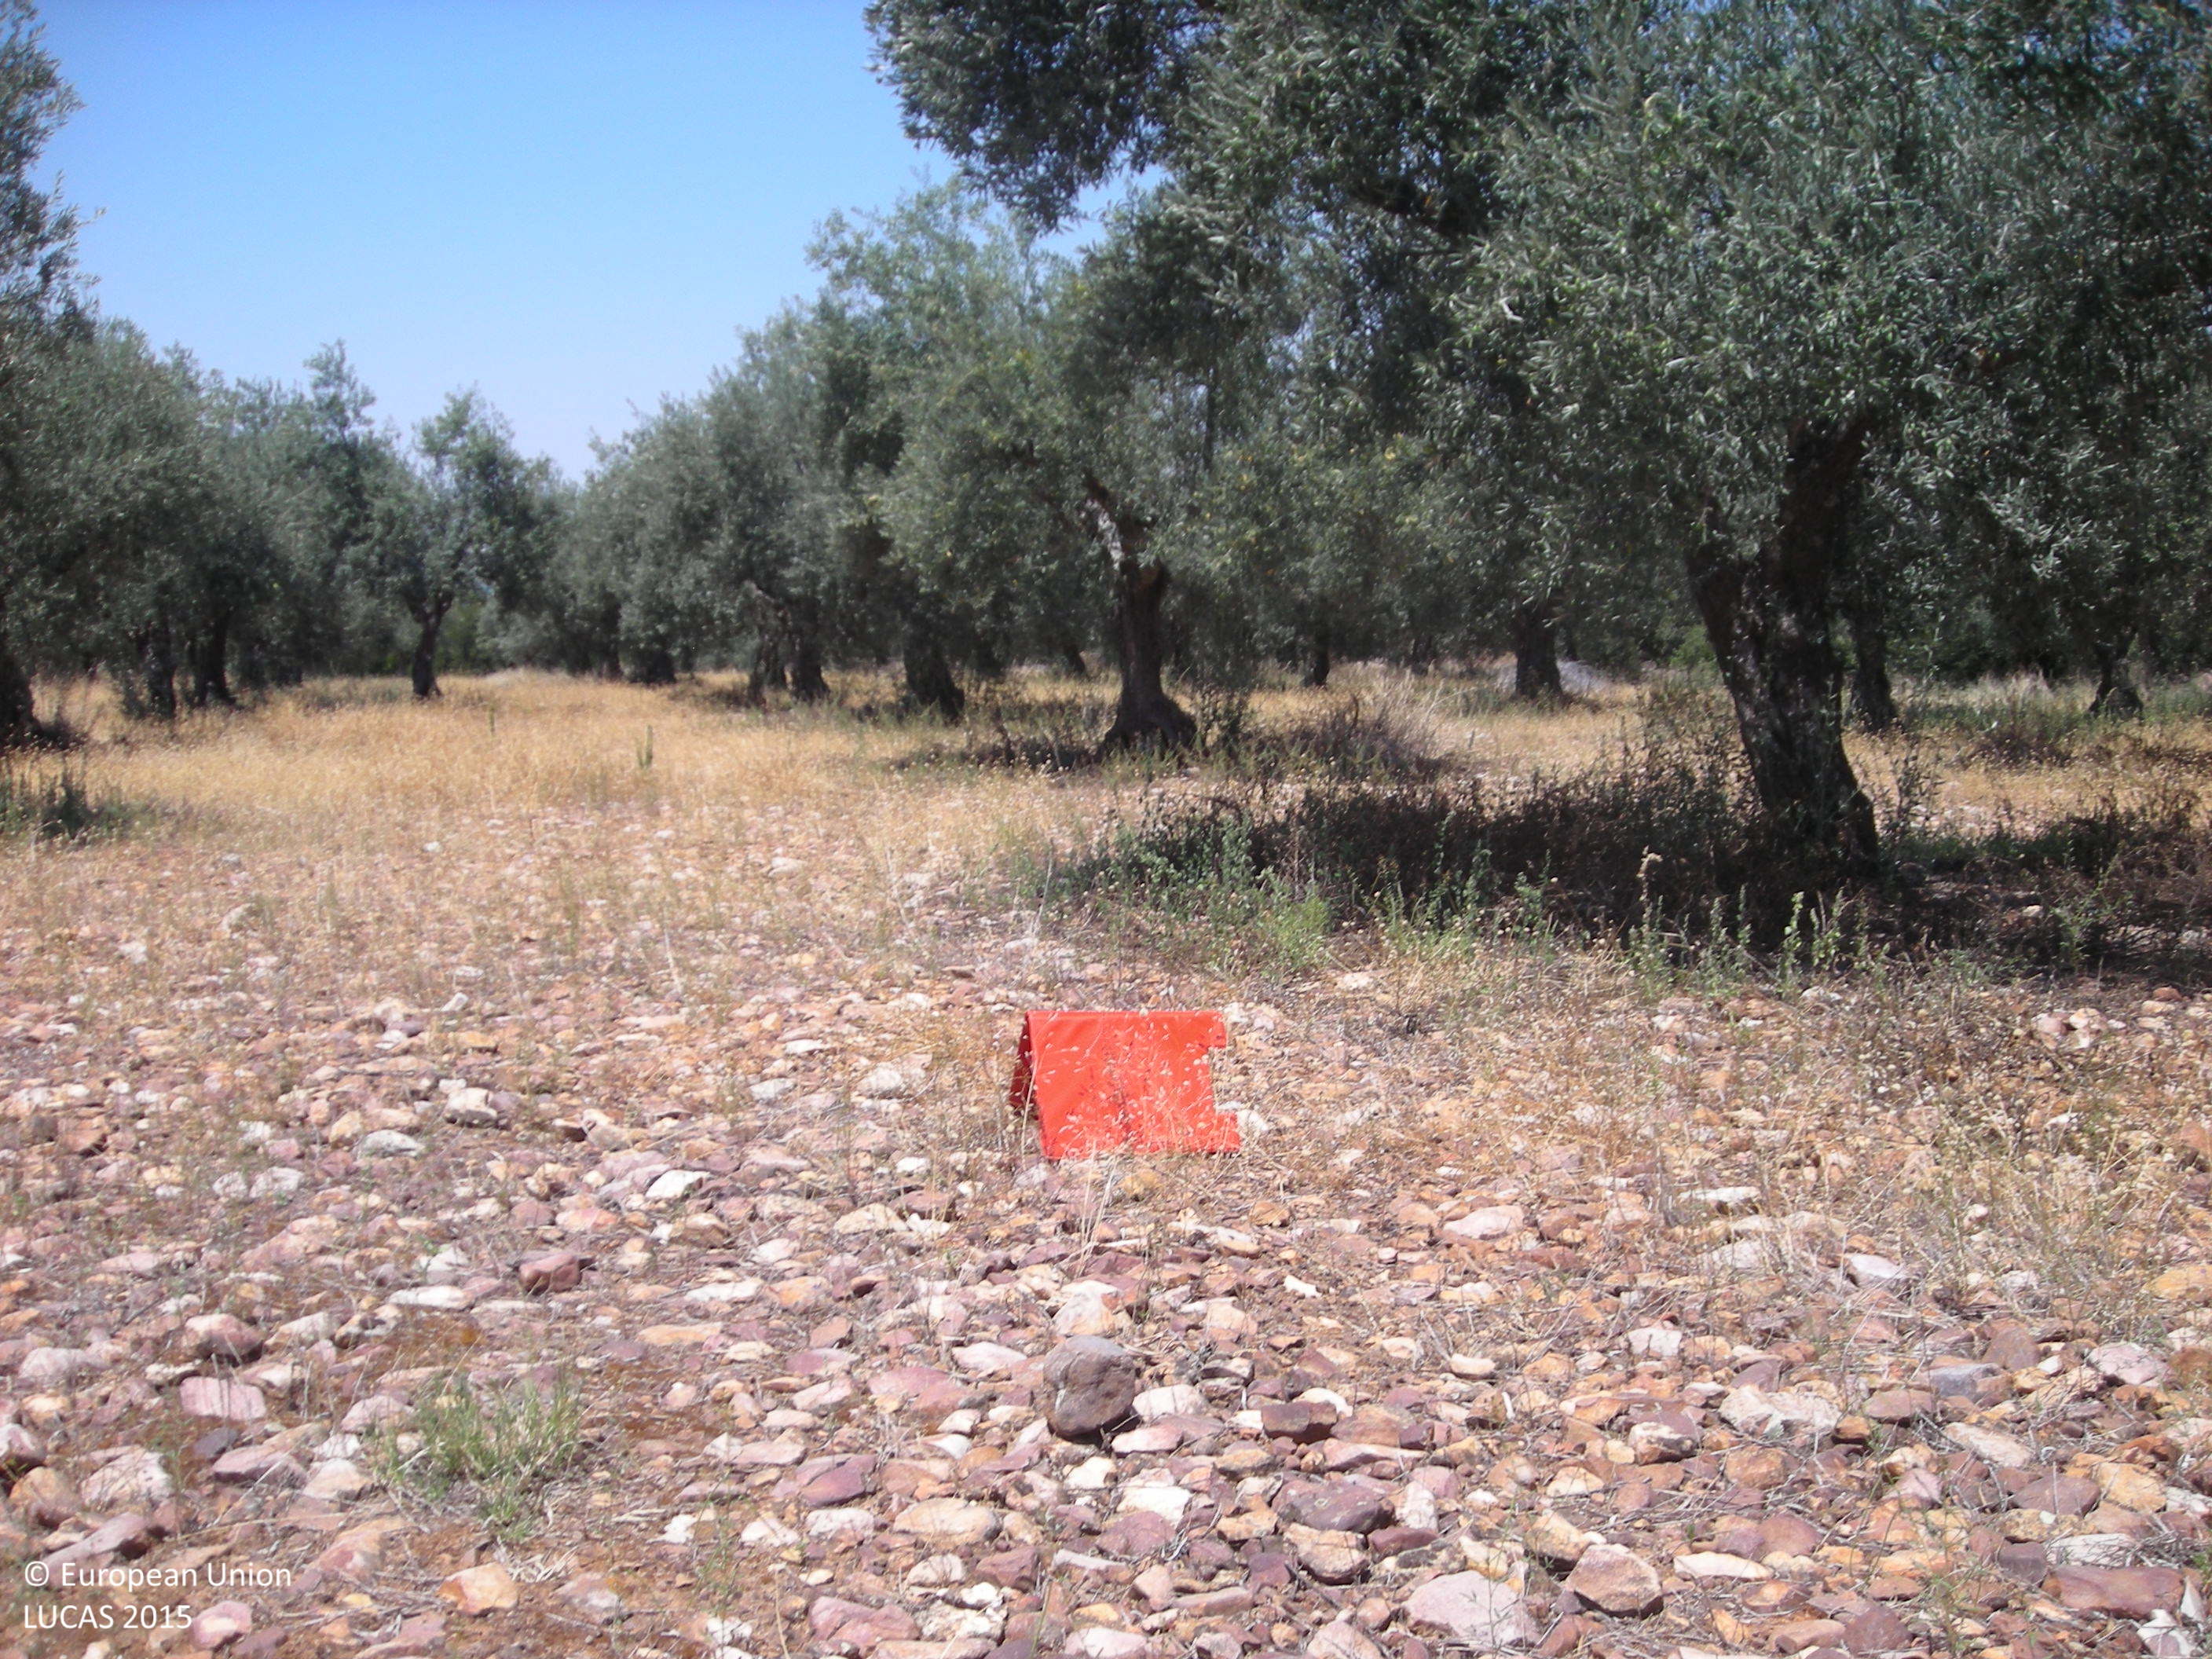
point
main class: Cropland
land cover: Olive groves
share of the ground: 50 - 75 %
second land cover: Grassland without tree/shrub cover
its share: 50 - 75 %
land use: Agriculture (excluding fallow land and kitchen gardens)
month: June
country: ES
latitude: 39.0784
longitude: -5.5236
